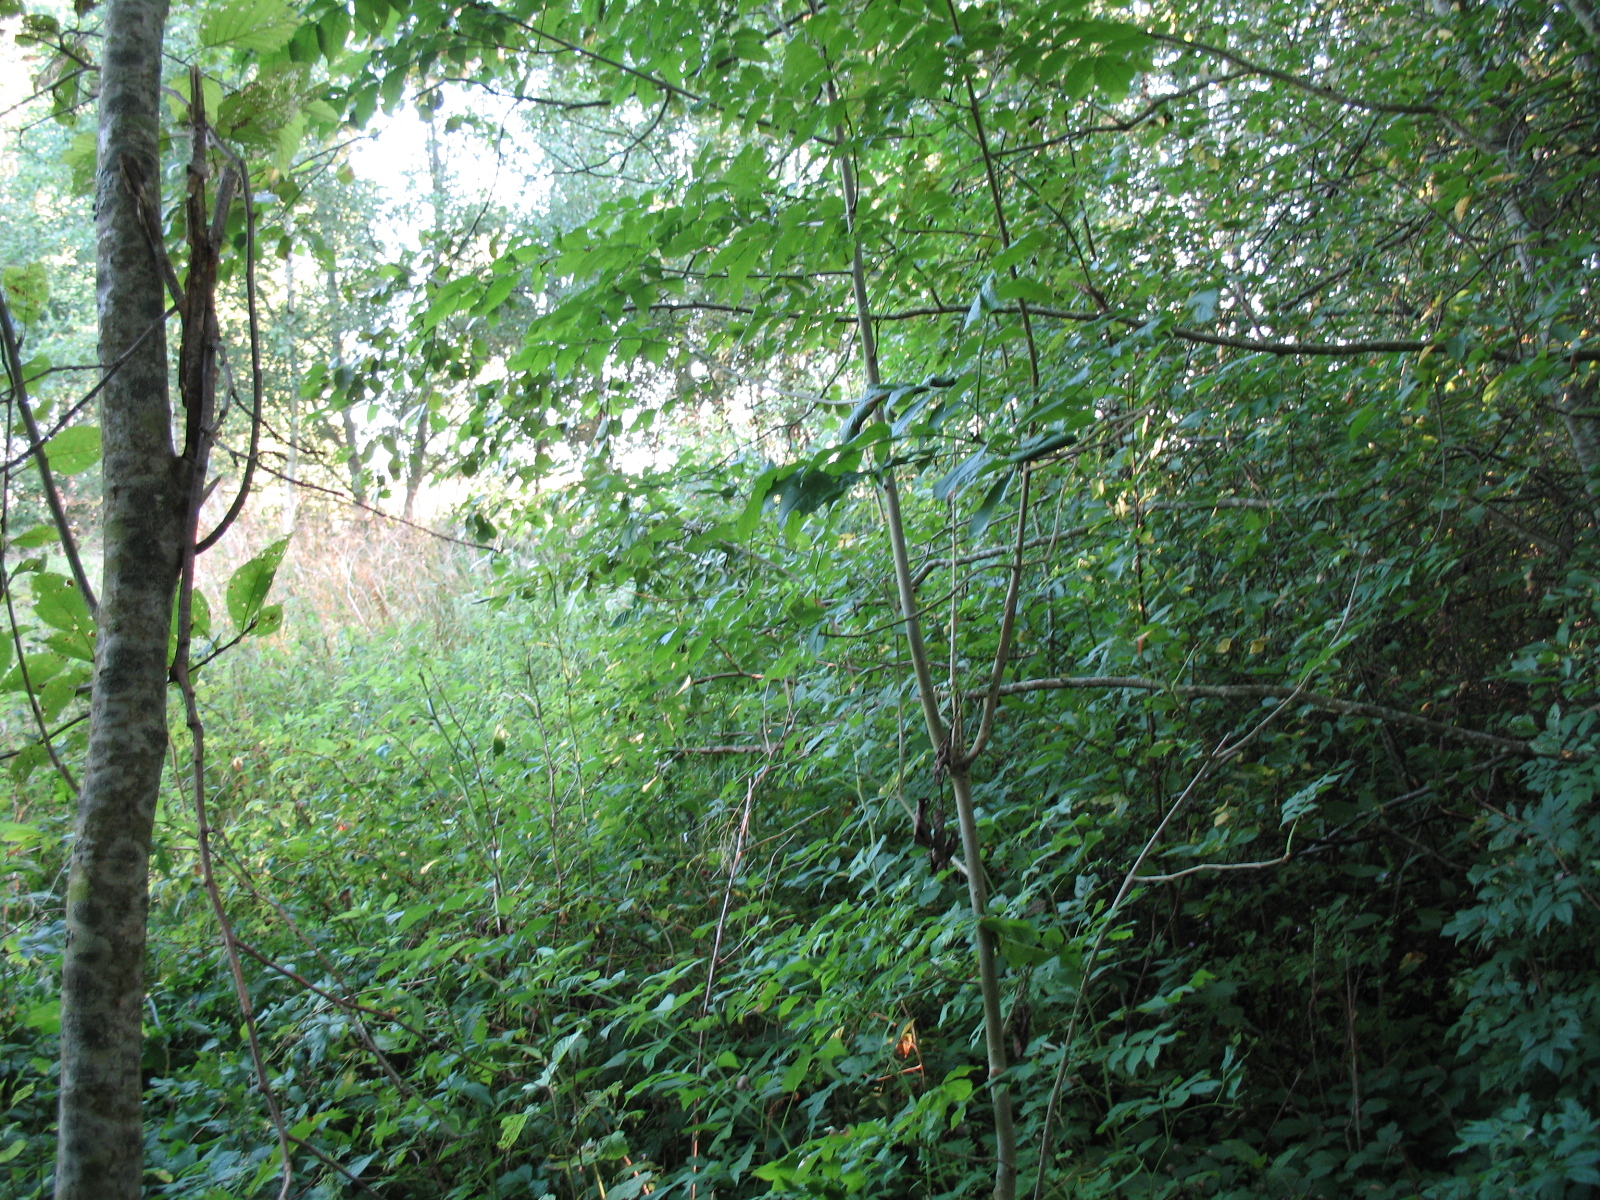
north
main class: Woodland
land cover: Broadleaved woodland
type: non-riverine alder, birch or aspen forest
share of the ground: > 75 %
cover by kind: broadleaved forest trees 90 %, shrubs 5 %, herbaceous plants 5 %
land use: Forestry
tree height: > 5 m
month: August
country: LV
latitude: 56.2506
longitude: 25.4691
